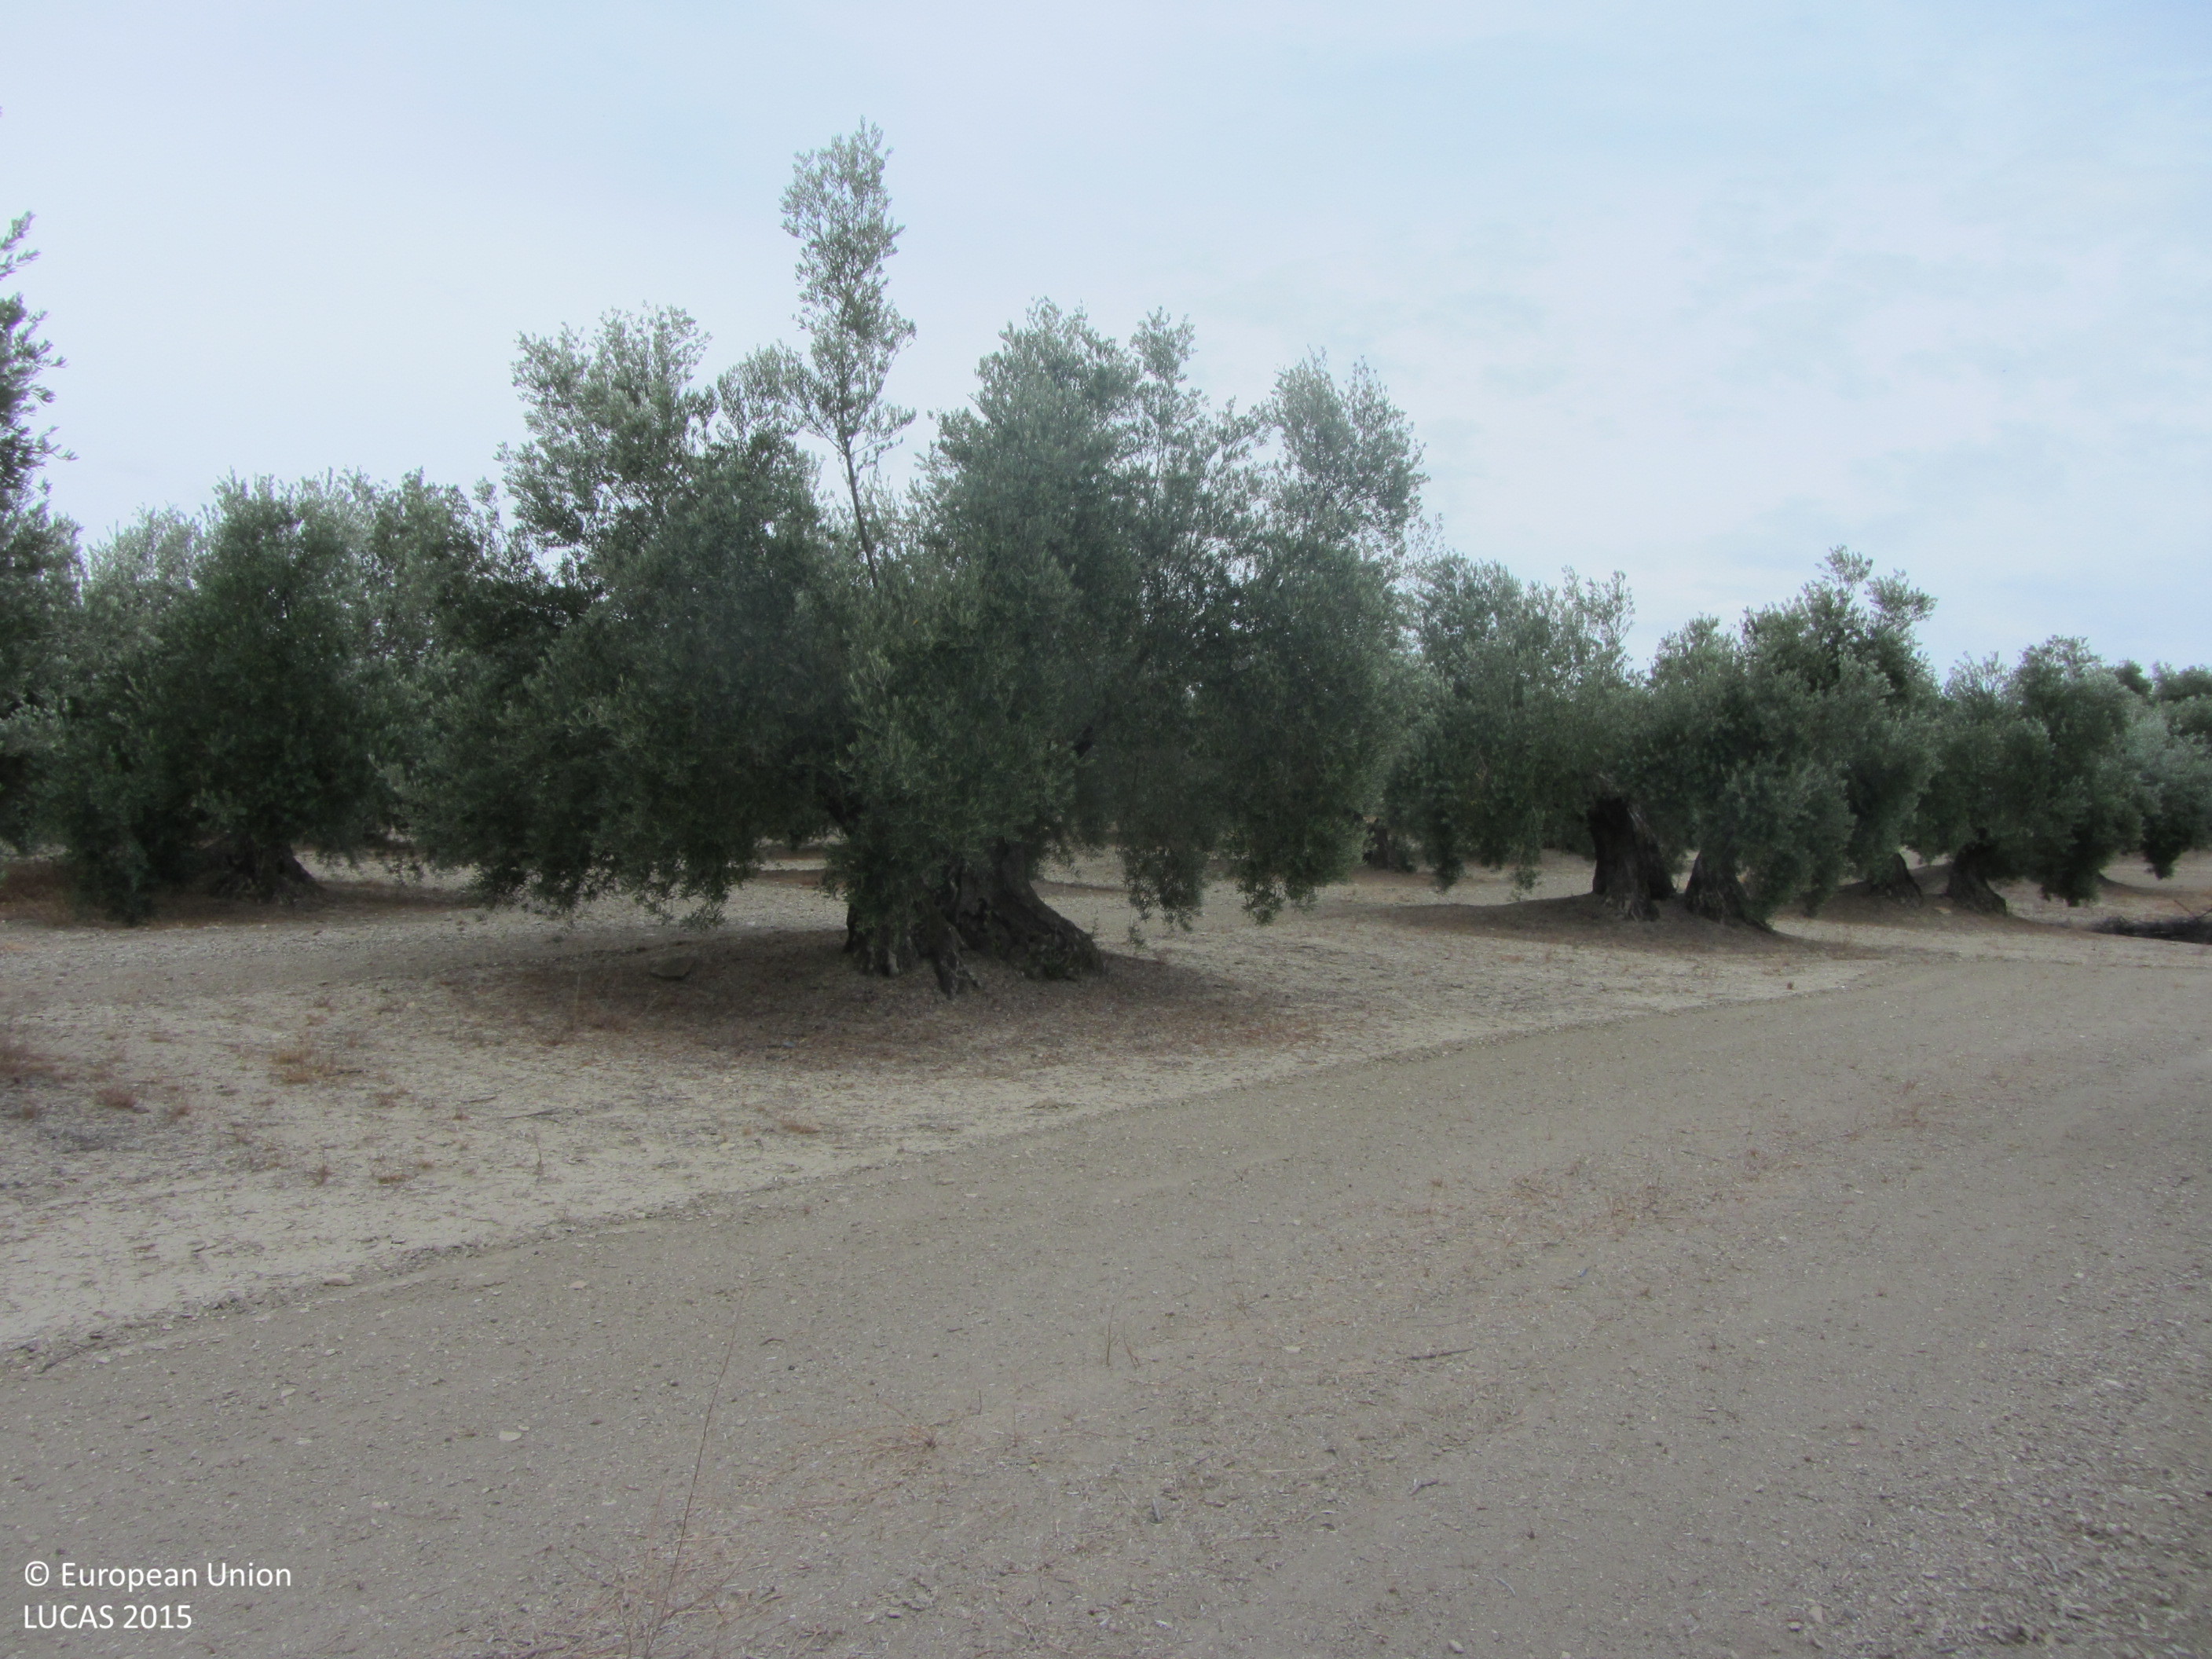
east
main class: Cropland
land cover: Olive groves
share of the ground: 25 - 50 %
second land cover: Other bare soil
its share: > 75 %
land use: Agriculture (excluding fallow land and kitchen gardens)
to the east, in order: Olive groves; Other bare soil
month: June
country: ES
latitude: 38.0060
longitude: -3.2670
